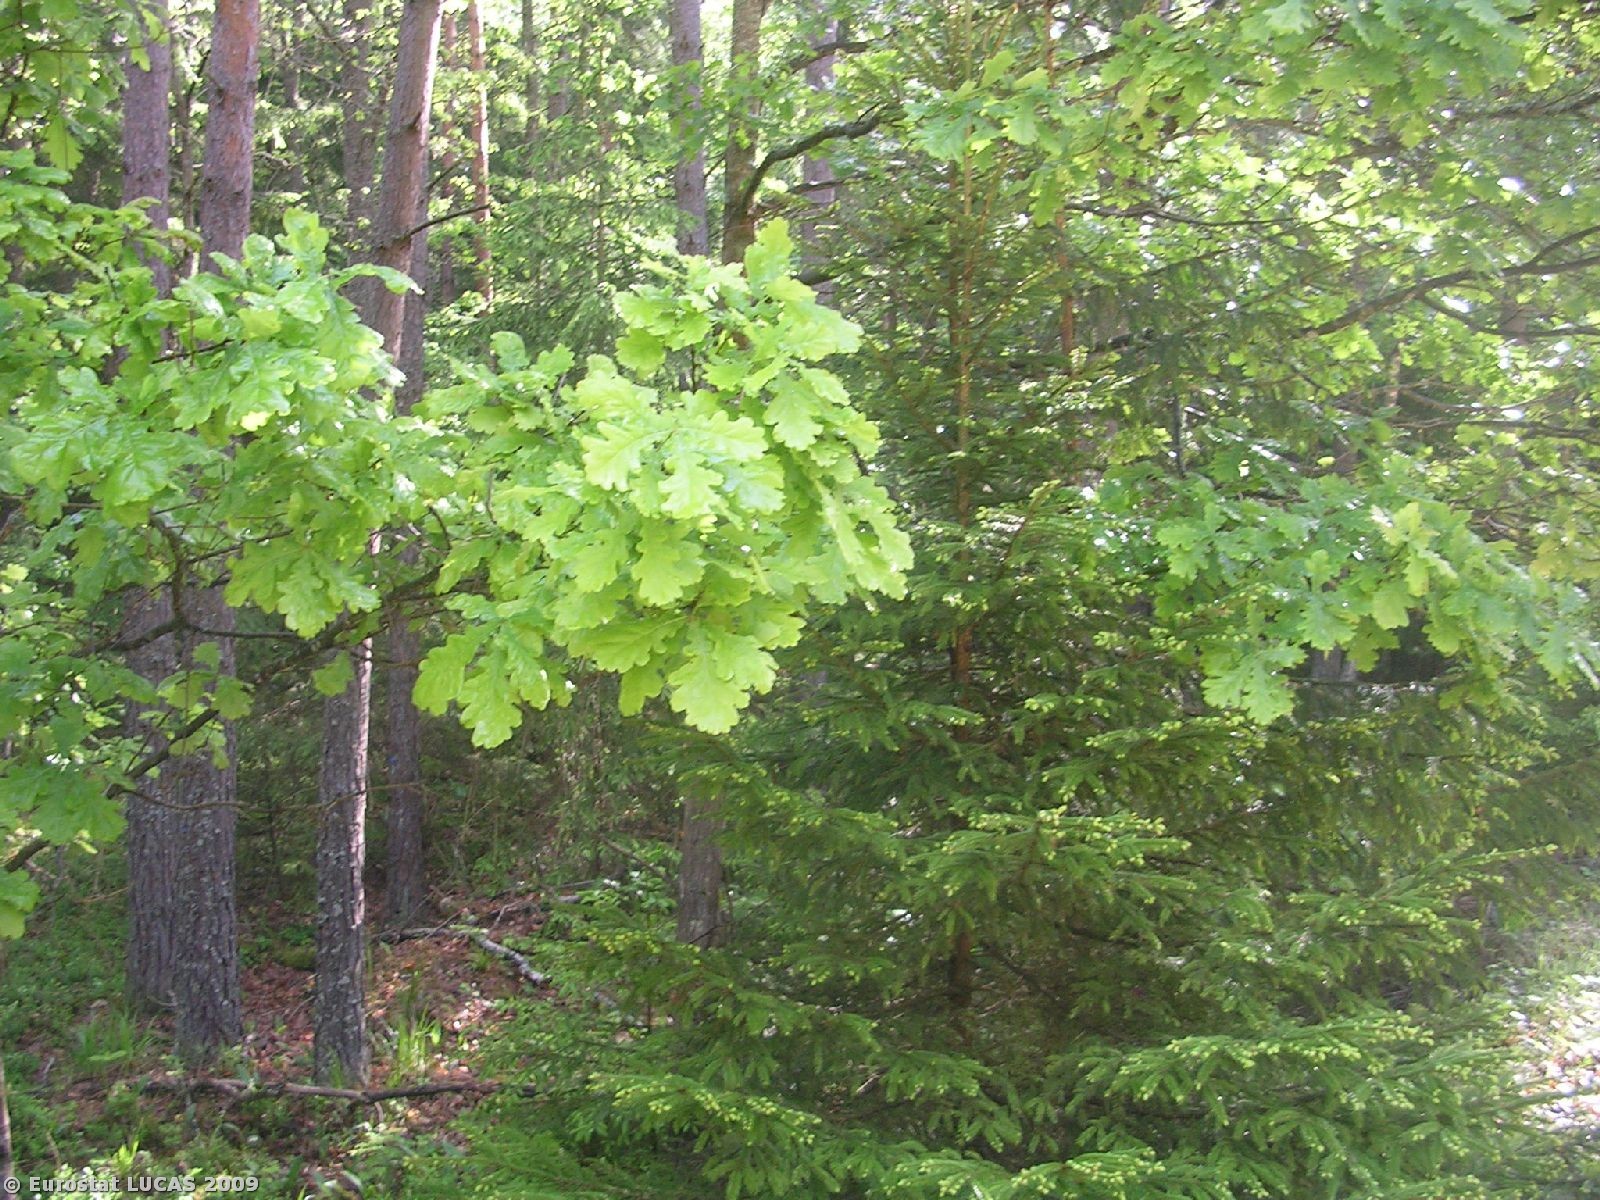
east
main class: Woodland
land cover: Mixed woodland
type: hemiboreal forest and nemoral coniferous forest and mixed broadleaved-coniferous forest
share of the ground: > 75 %
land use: Nature reserves
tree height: > 5 m
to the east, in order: Mixed woodland
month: May
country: PL
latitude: 53.2571
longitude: 23.3775
